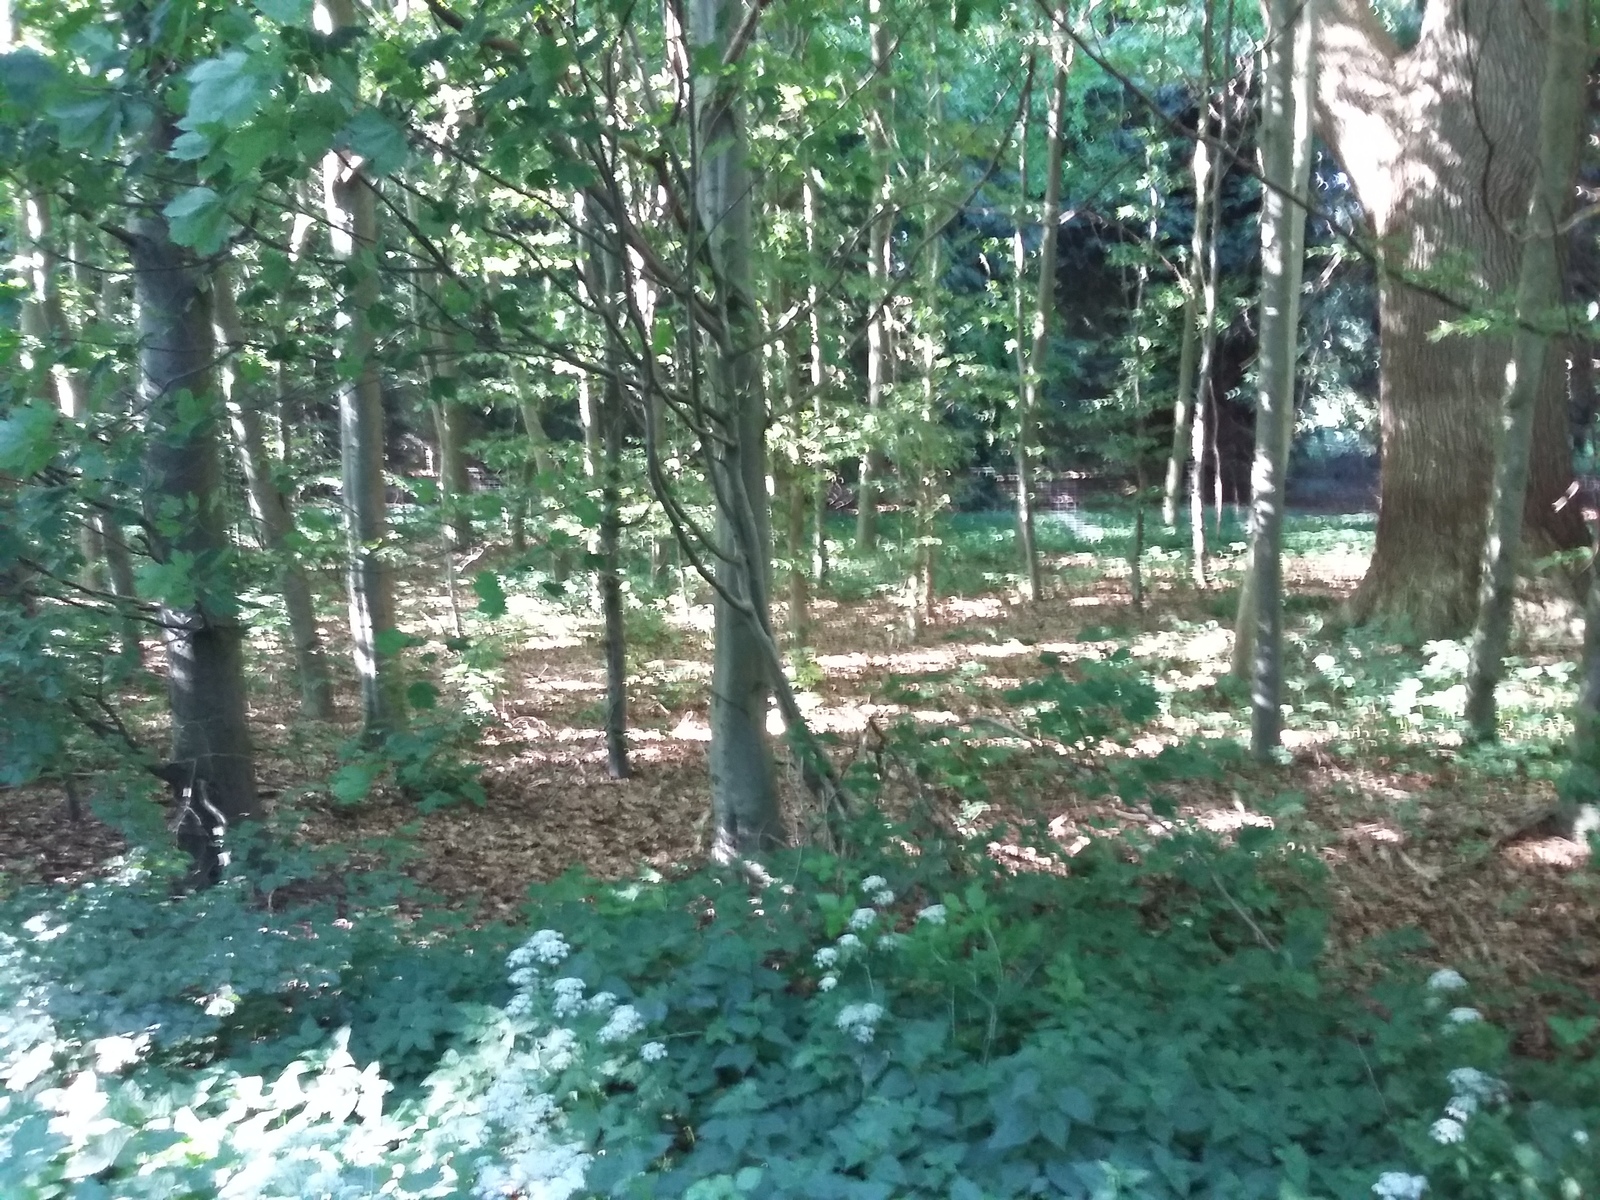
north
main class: Woodland
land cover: Broadleaved woodland
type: beech forest
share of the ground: > 75 %
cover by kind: broadleaved forest trees 90 %, herbaceous plants 10 %
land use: Forestry
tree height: > 5 m
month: July
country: DK
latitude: 55.0381
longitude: 12.0798
